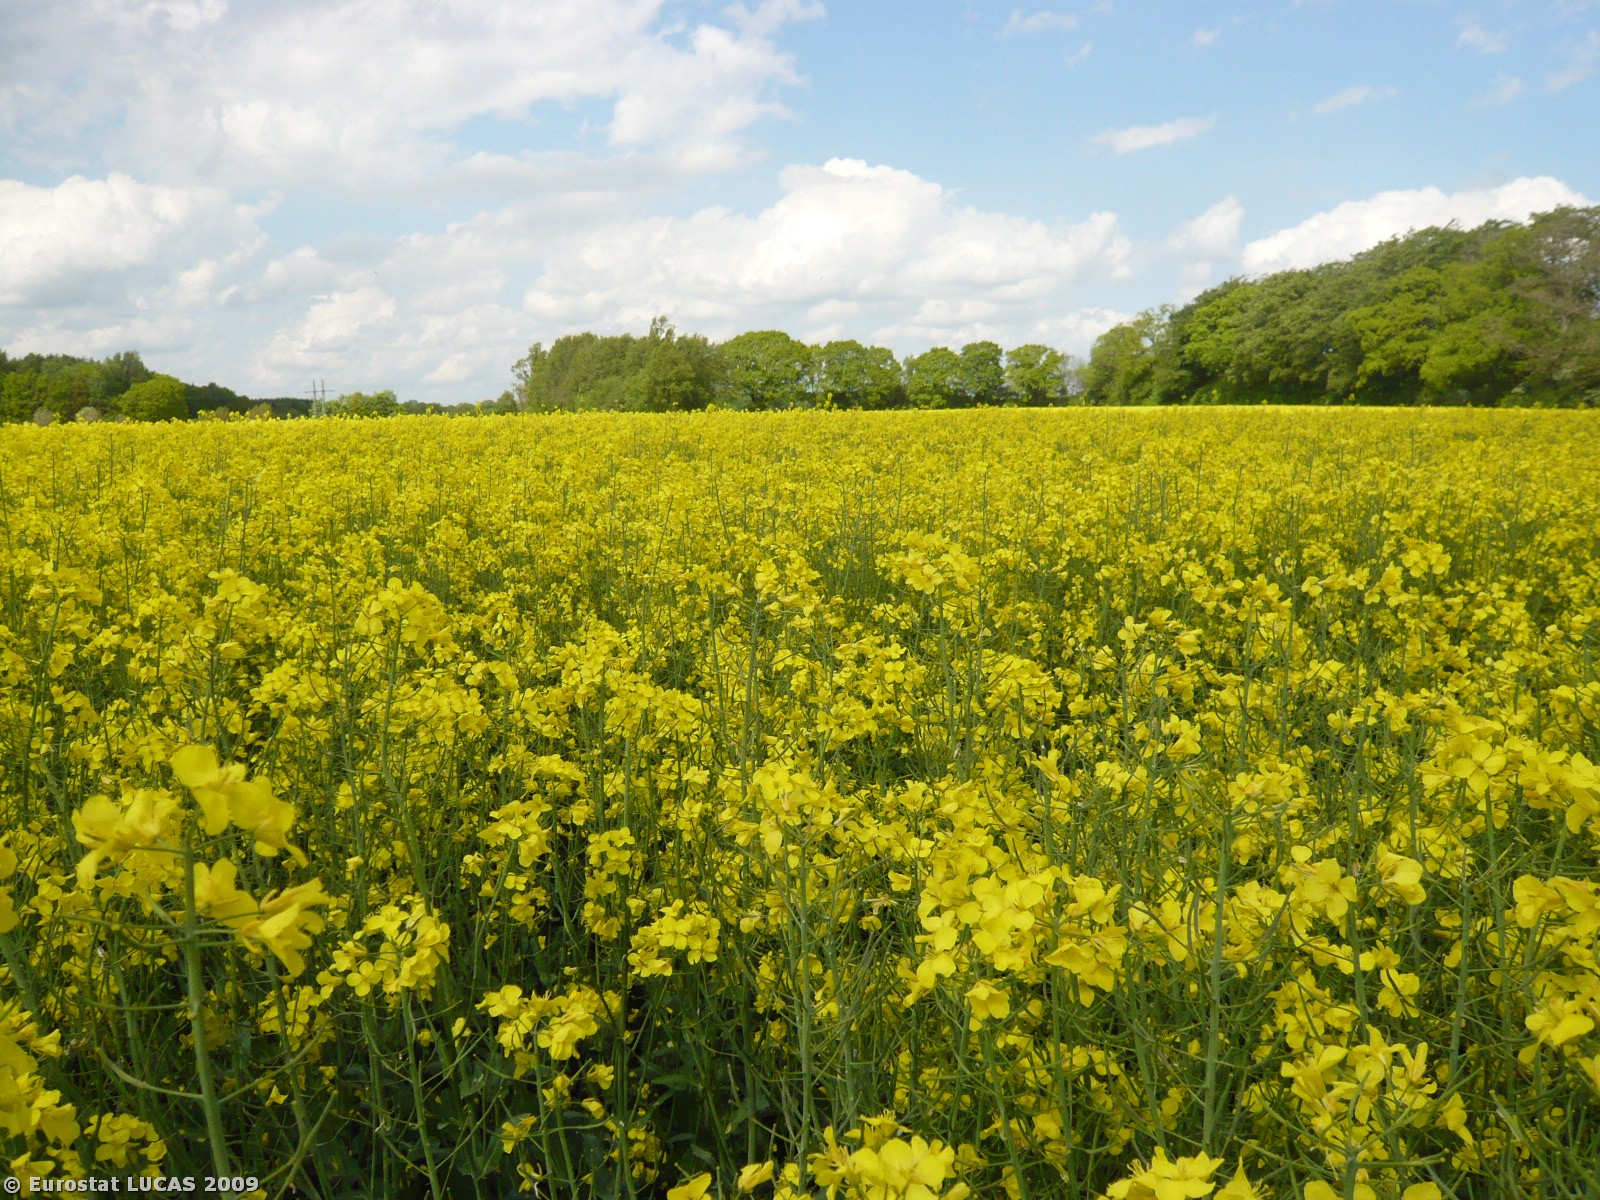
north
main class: Cropland
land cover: Rape and turnip rape
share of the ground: > 75 %
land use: Agriculture (excluding fallow land and kitchen gardens)
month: May
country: DK
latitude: 55.4154
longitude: 12.0993
